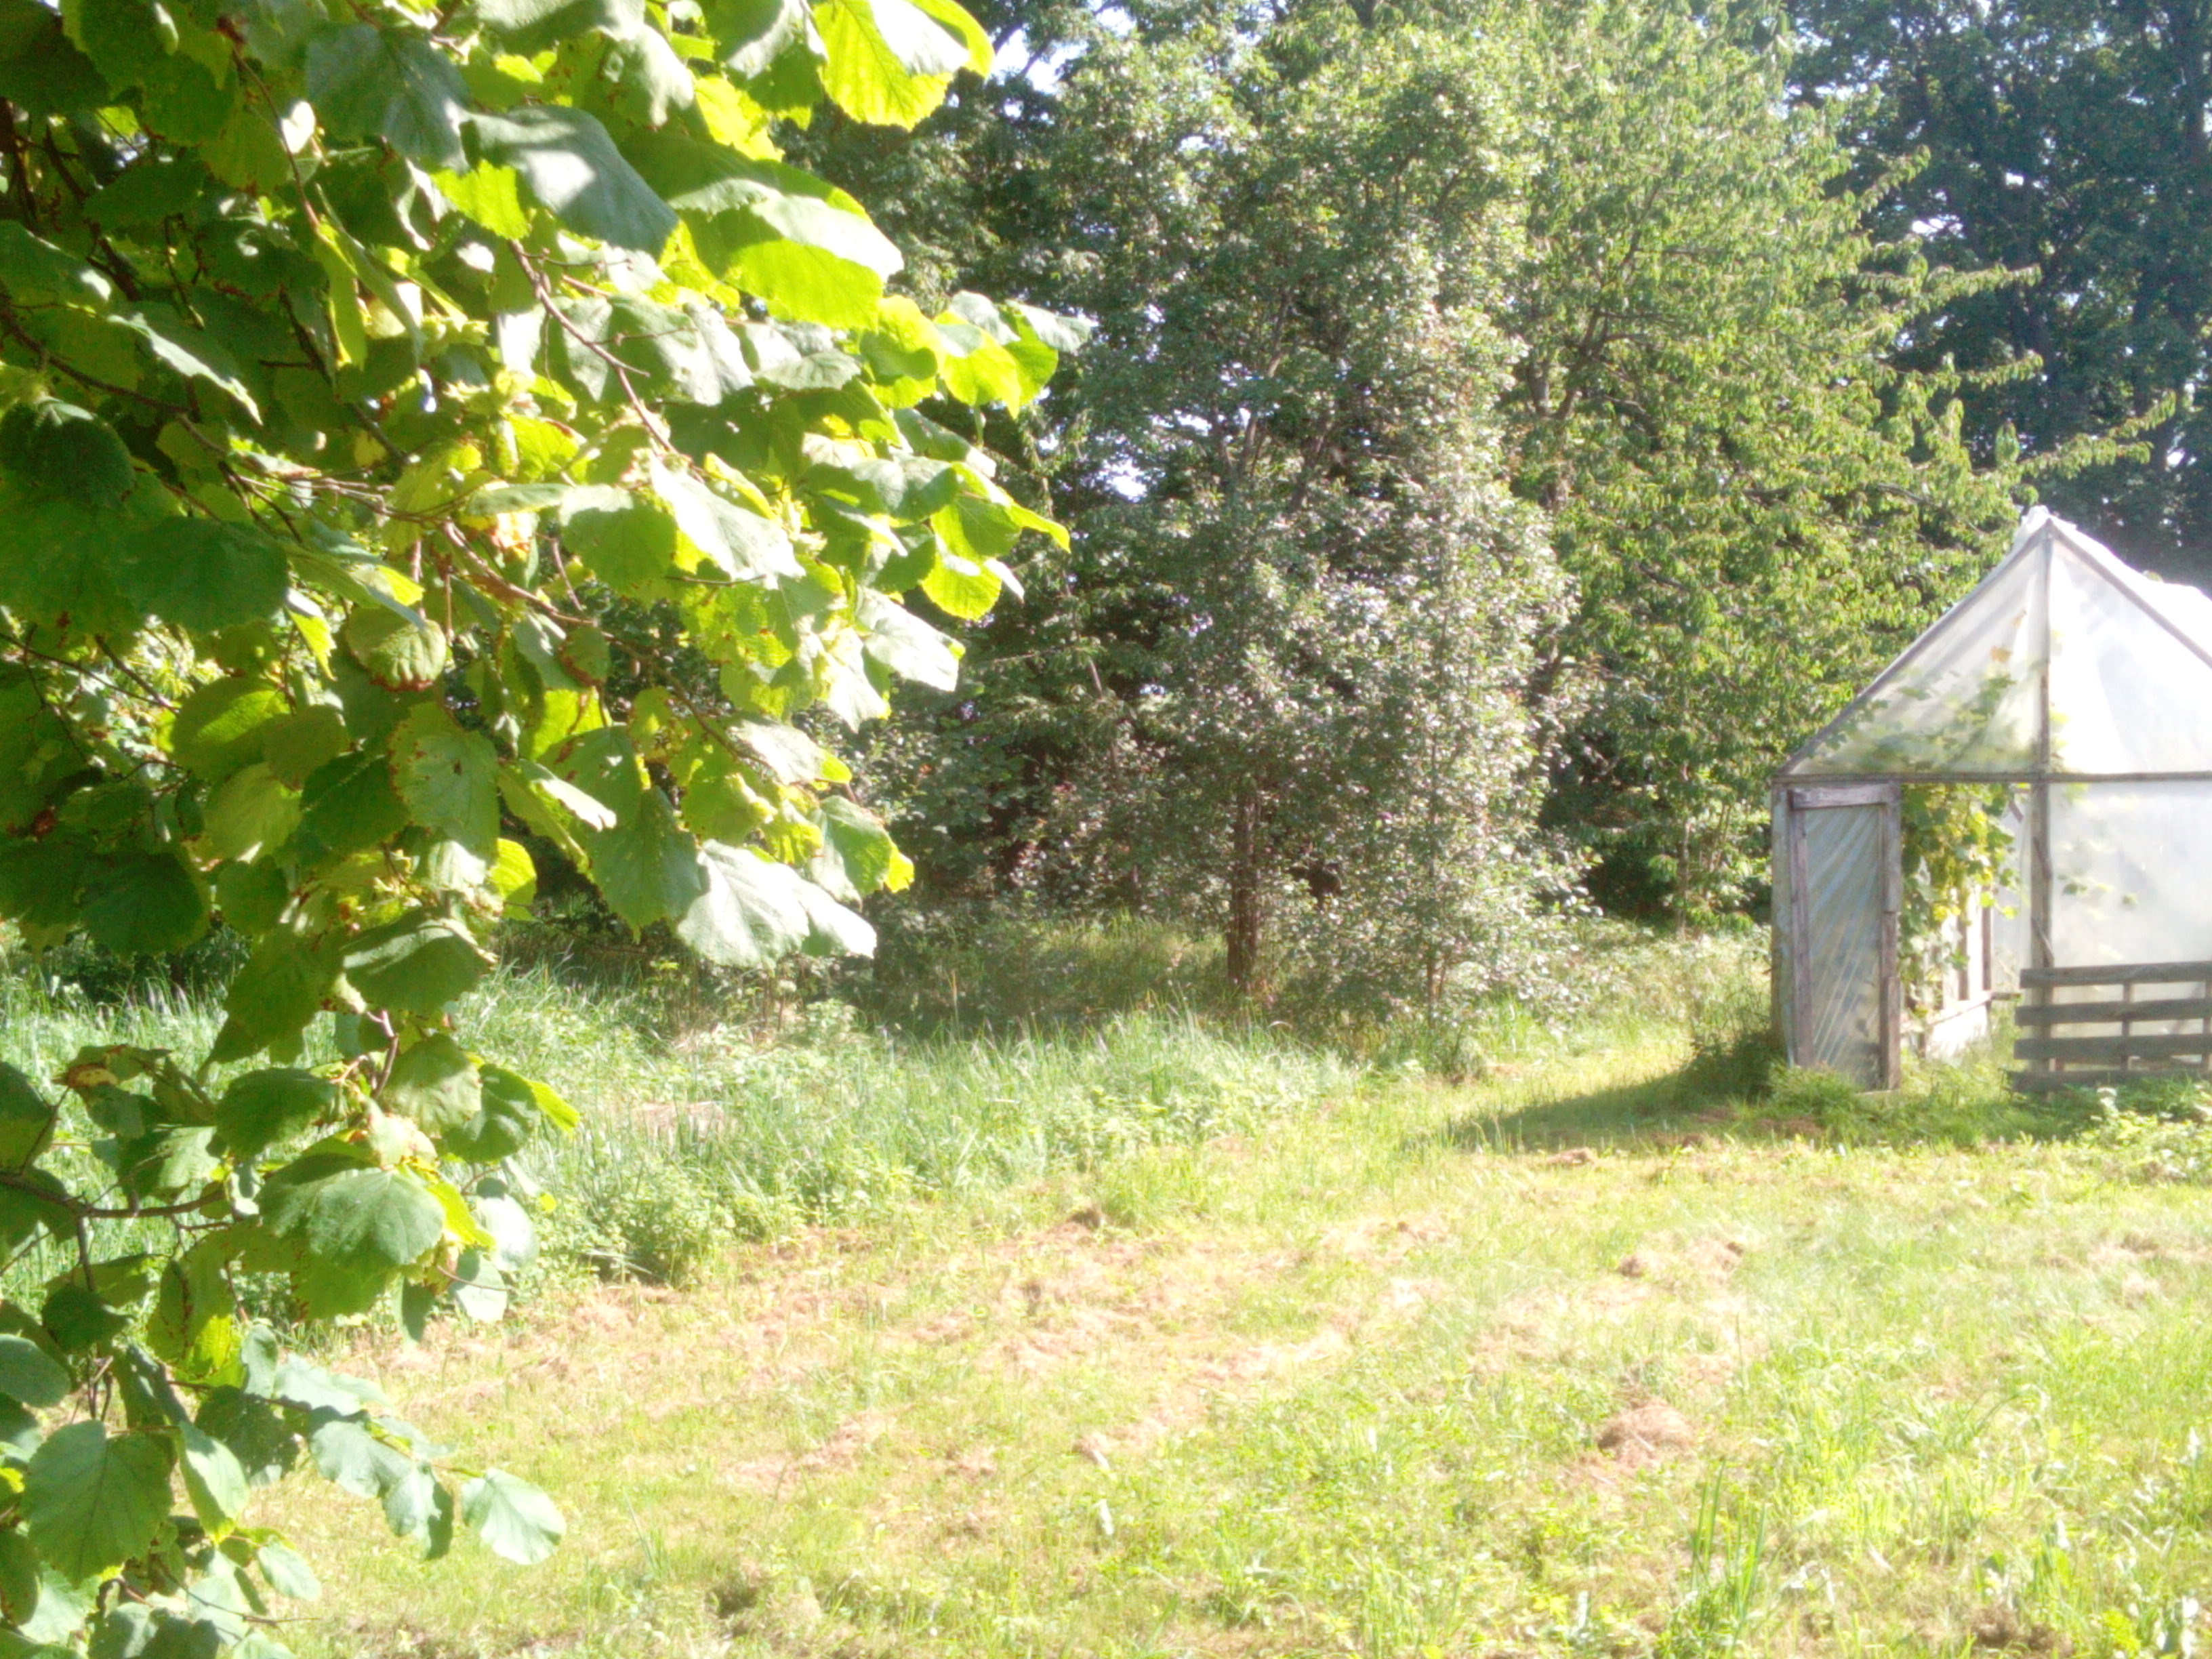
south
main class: Cropland
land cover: Apple fruit
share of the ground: 25 - 50 %
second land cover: Grassland without tree/shrub cover
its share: > 75 %
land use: Kitchen garden
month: August
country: LV
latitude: 56.6103
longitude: 21.1323
